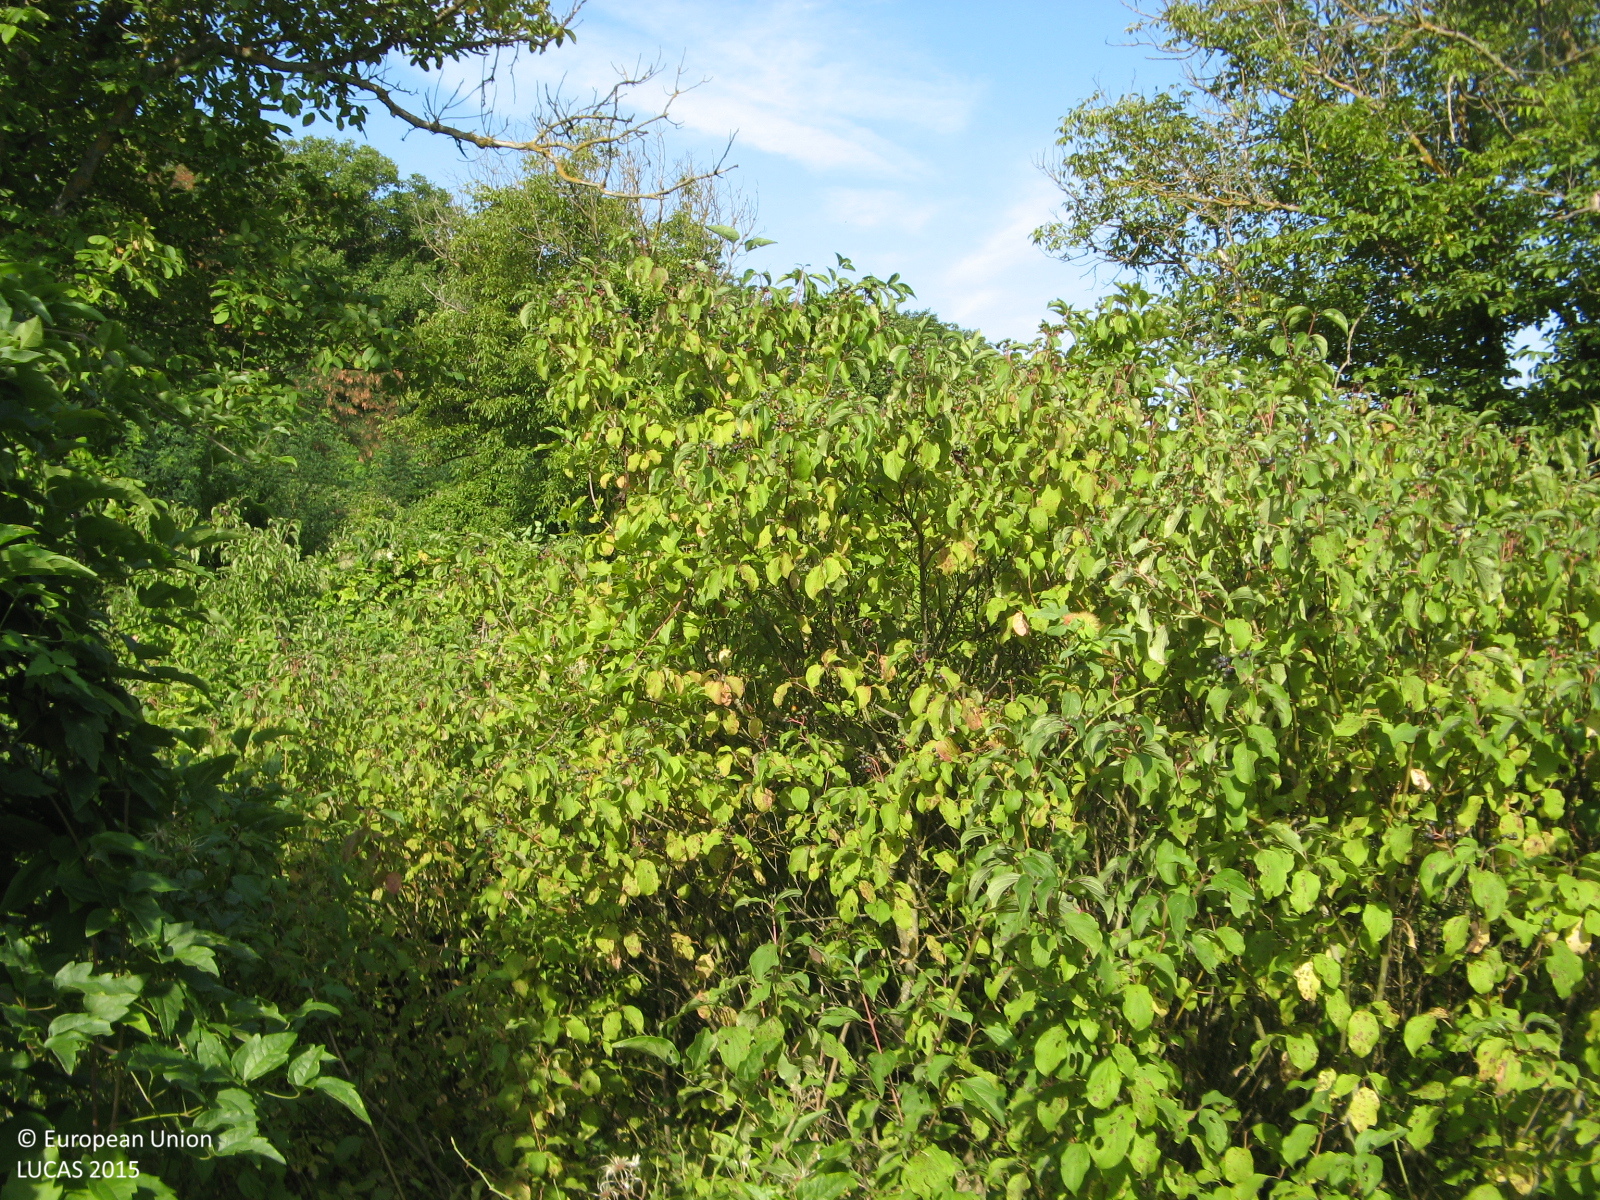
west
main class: Woodland
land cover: Broadleaved woodland
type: thermophilous deciduous forest
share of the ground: > 75 %
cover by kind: broadleaved forest trees 85 %, shrubs 10 %, herbaceous plants 5 %
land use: Forestry
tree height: > 5 m
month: August
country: BG
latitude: 43.5678
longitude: 25.3452
